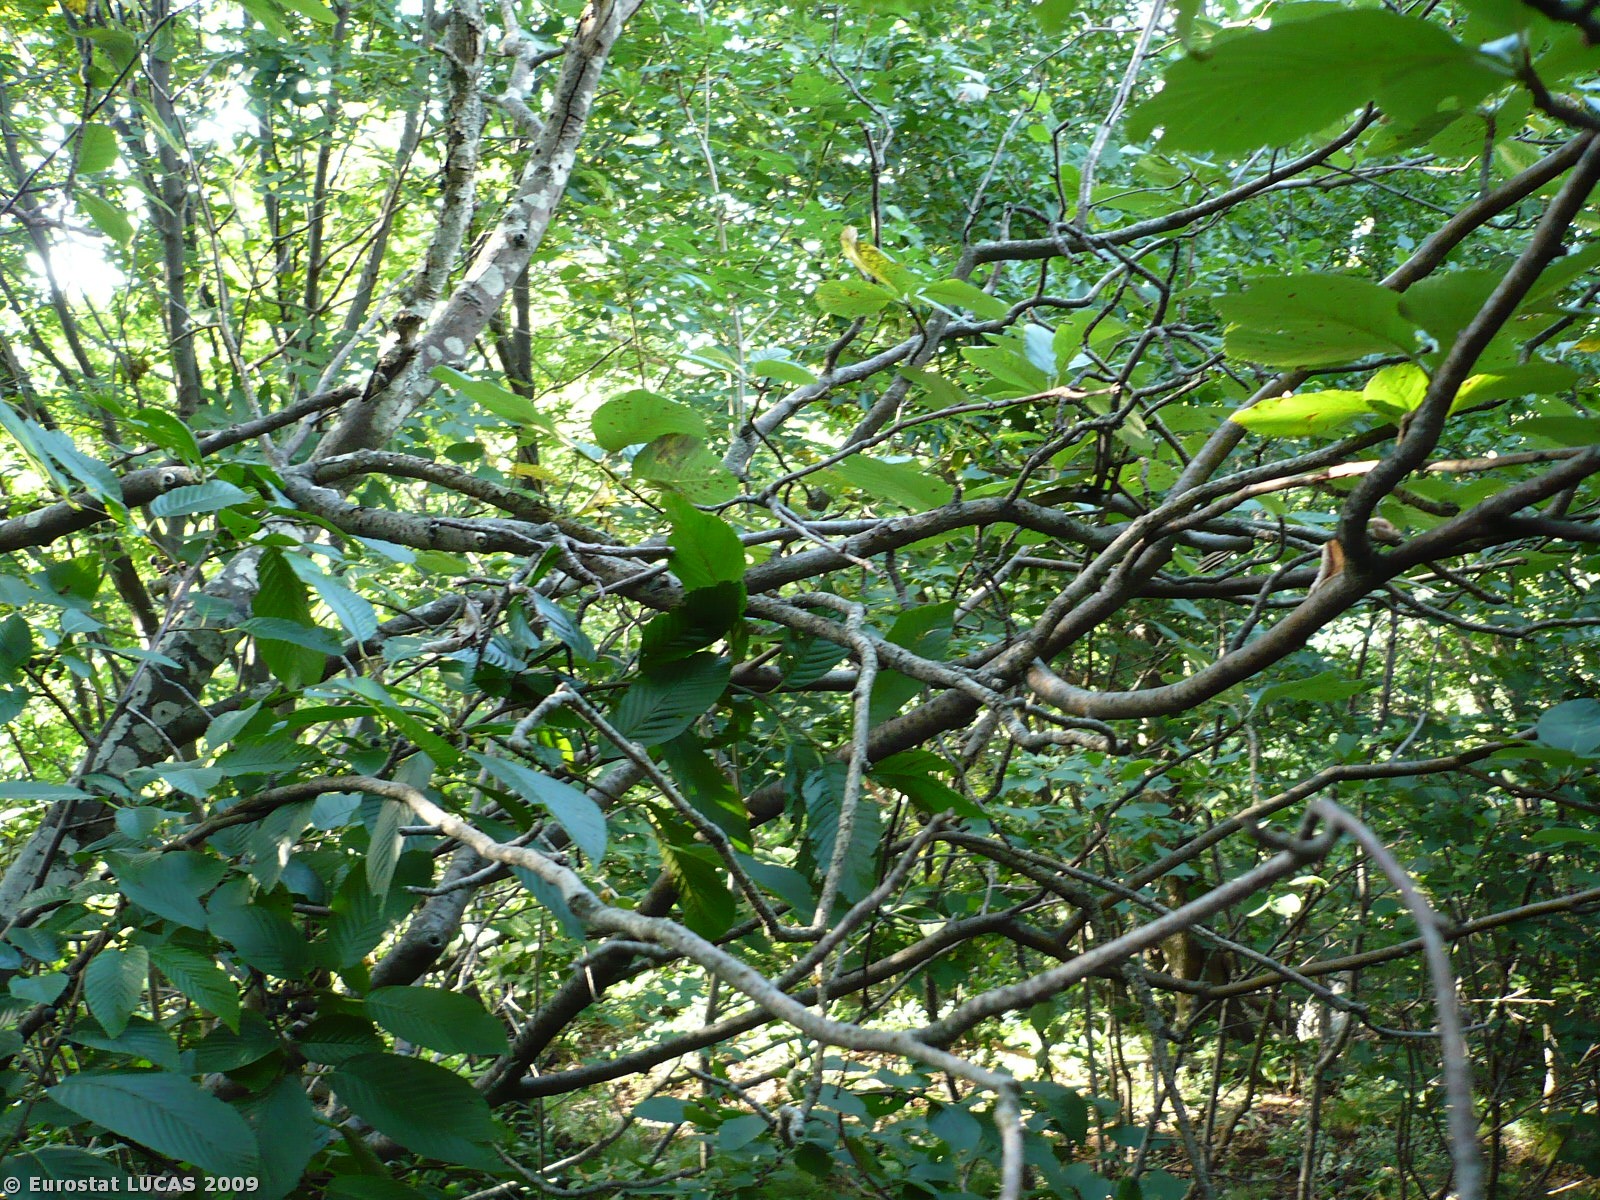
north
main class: Woodland
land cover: Broadleaved woodland
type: thermophilous deciduous forest
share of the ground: > 75 %
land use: Unused
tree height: > 5 m
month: July
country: SI
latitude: 45.5607
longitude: 14.3129
